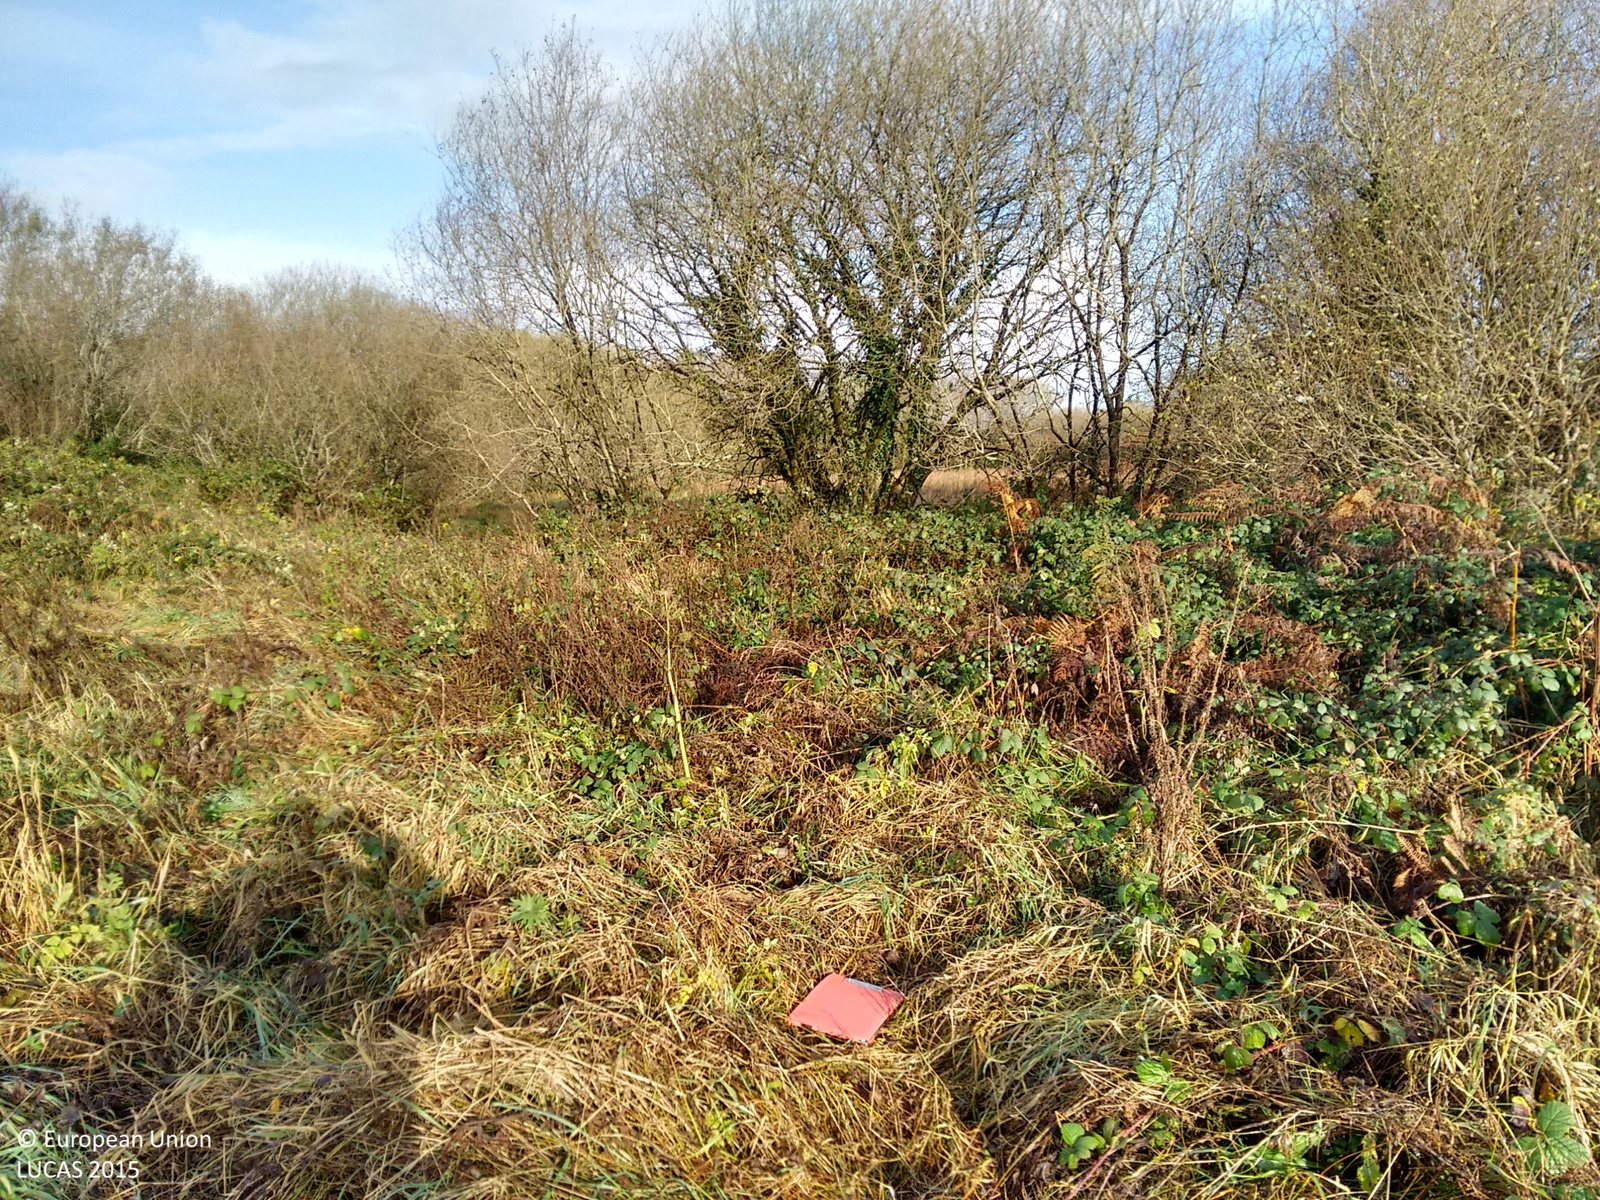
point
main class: Grassland
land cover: Spontaneously vegetated surfaces
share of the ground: > 75 %
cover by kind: herbaceous plants 95 %, shrubs 5 %
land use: Semi-natural and natural areas not in use
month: November
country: IE
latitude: 53.9793
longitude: -7.9676
